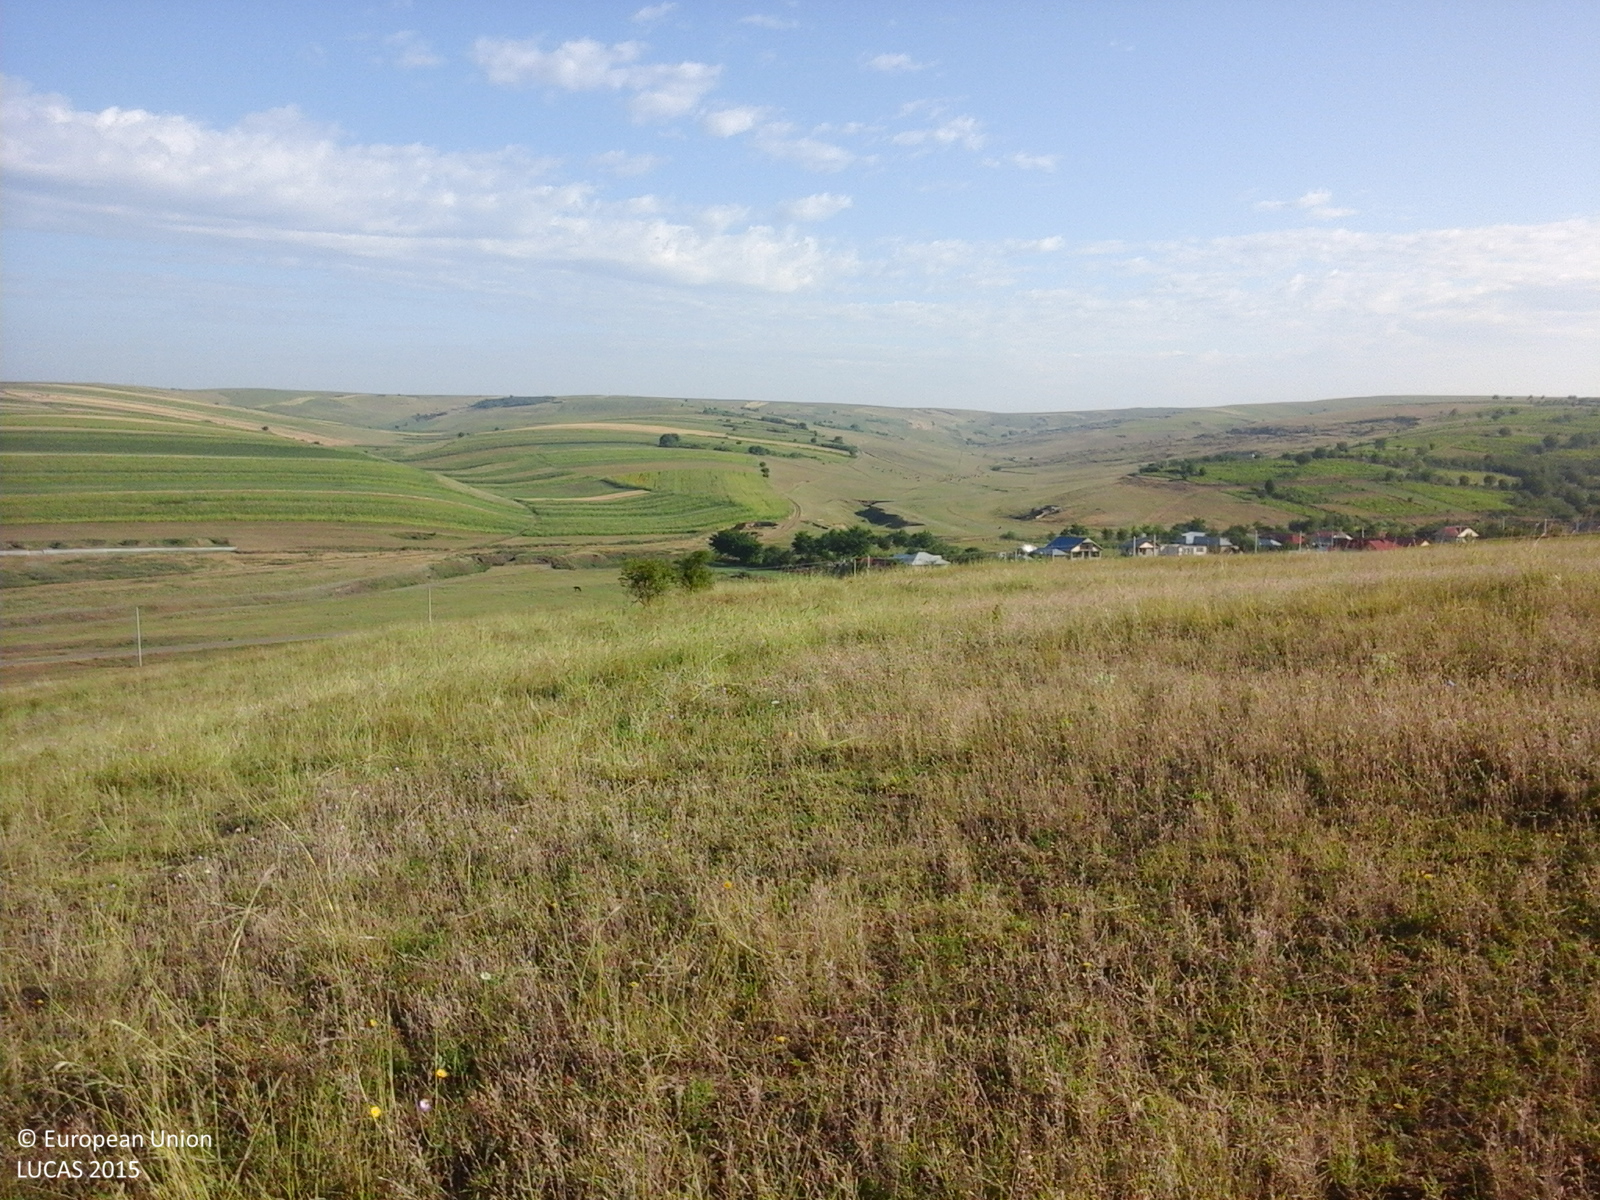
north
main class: Grassland
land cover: Grassland without tree/shrub cover
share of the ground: > 75 %
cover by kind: herbaceous plants 100 %
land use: Agriculture (excluding fallow land and kitchen gardens)
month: July
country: RO
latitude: 46.1959
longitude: 27.7522
